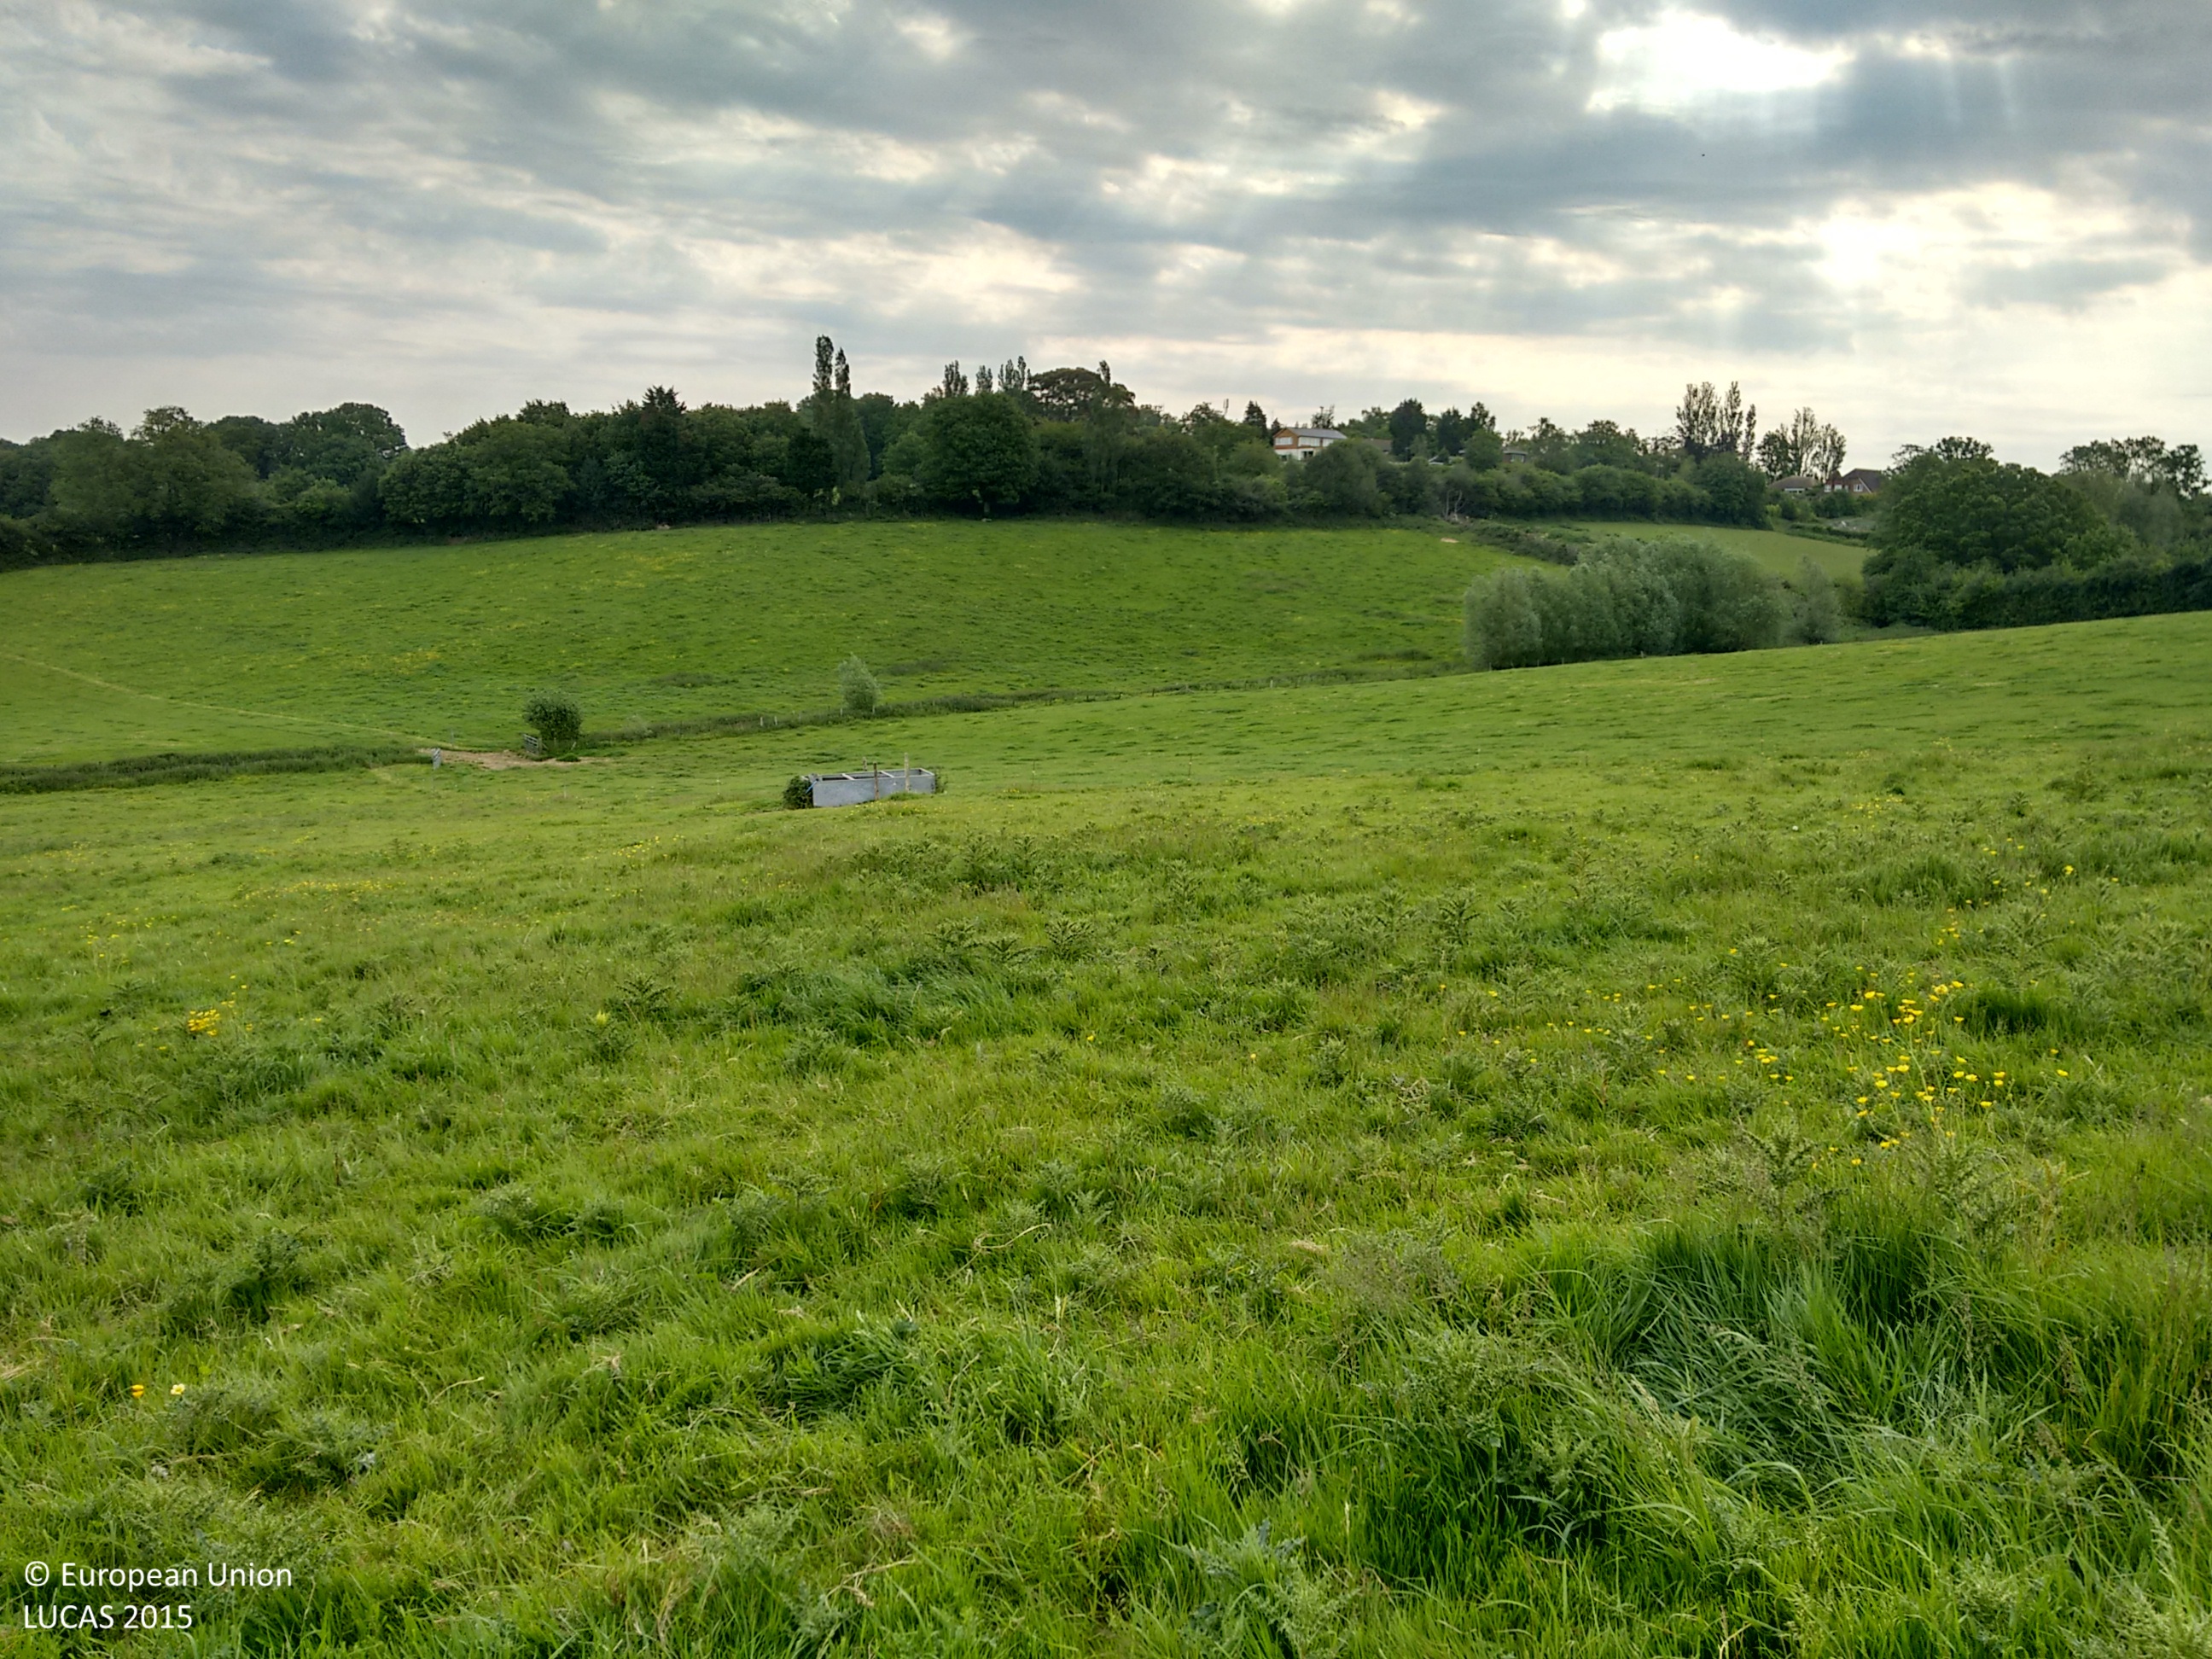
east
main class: Grassland
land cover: Grassland without tree/shrub cover
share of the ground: > 75 %
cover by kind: herbaceous plants 100 %
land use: Agriculture (excluding fallow land and kitchen gardens)
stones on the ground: < 10 %
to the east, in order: Grassland without tree/shrub cover; Fences; Grassland without tree/shrub cover; Fences; Shruby margins; Fences; Grassland without tree/shrub cover; Managed hedges
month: June
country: GB
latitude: 51.0870
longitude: 0.6798
